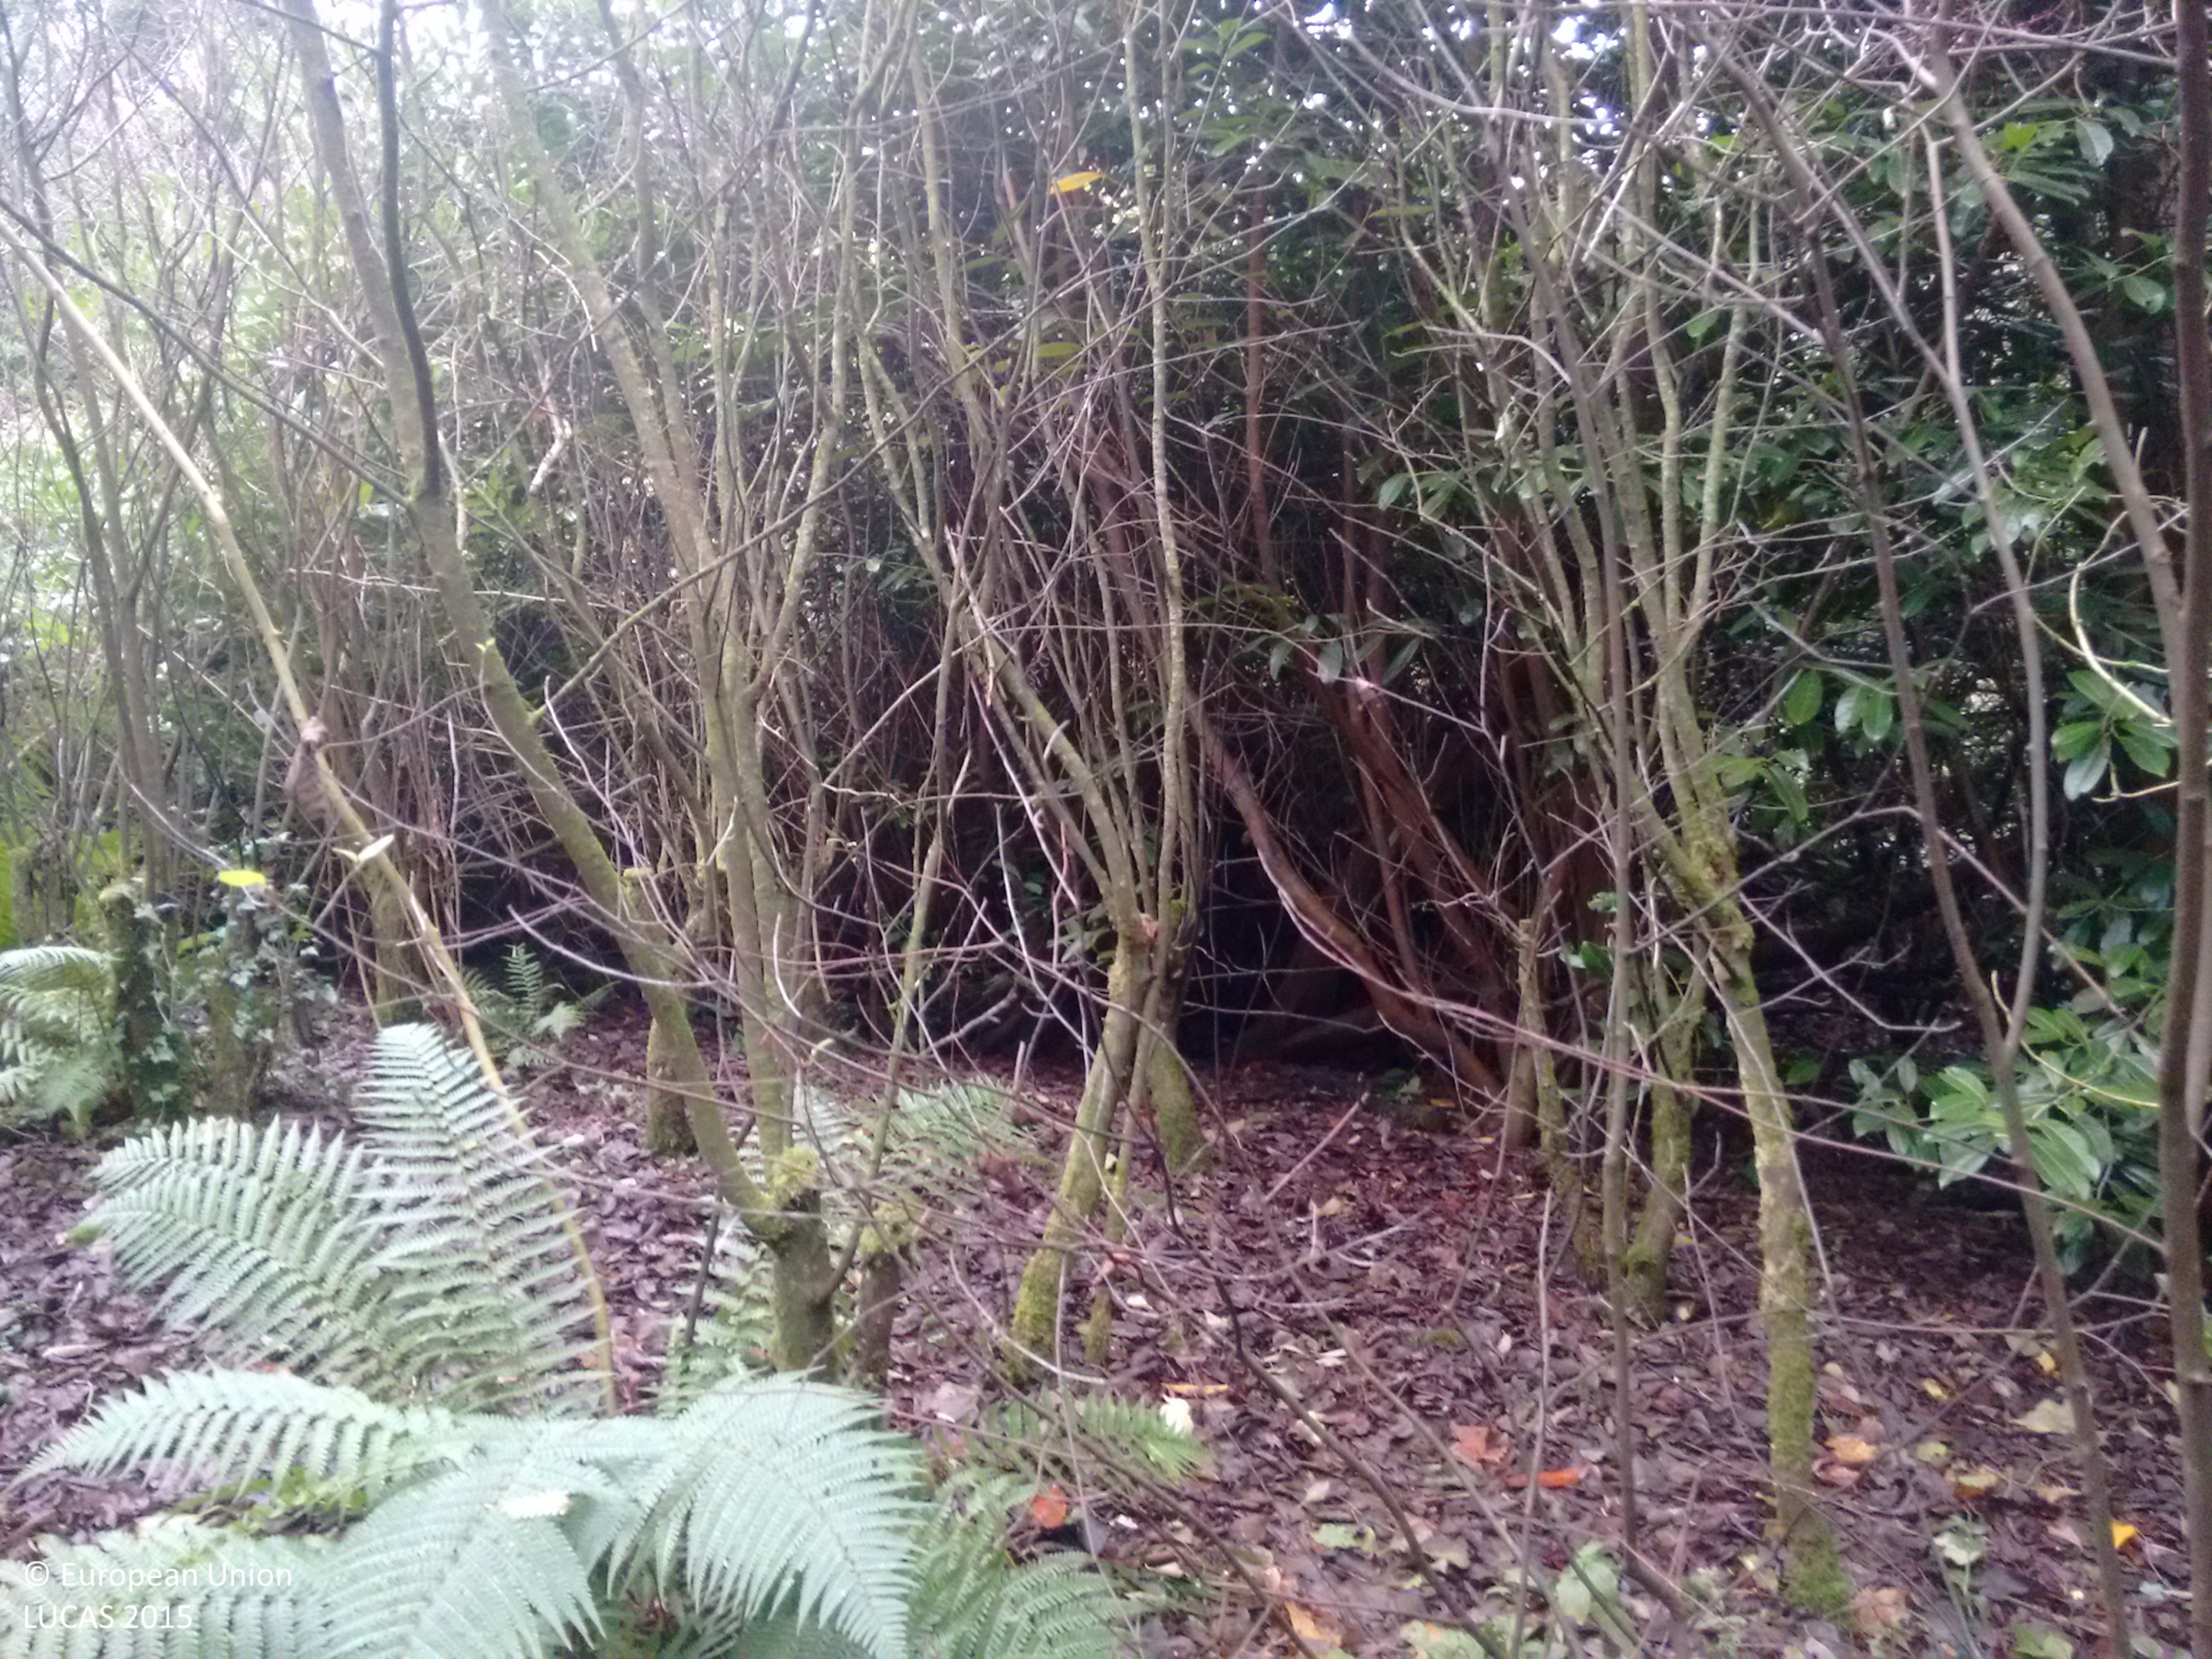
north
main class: Woodland
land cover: Other mixed woodland
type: exotic forest
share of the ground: > 75 %
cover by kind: broadleaved forest trees 60 %, coniferous forest trees 30 %, herbaceous plants 10 %
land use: Amenities, museums, leisure
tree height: > 5 m
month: November
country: GB
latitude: 54.5589
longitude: -5.9271
